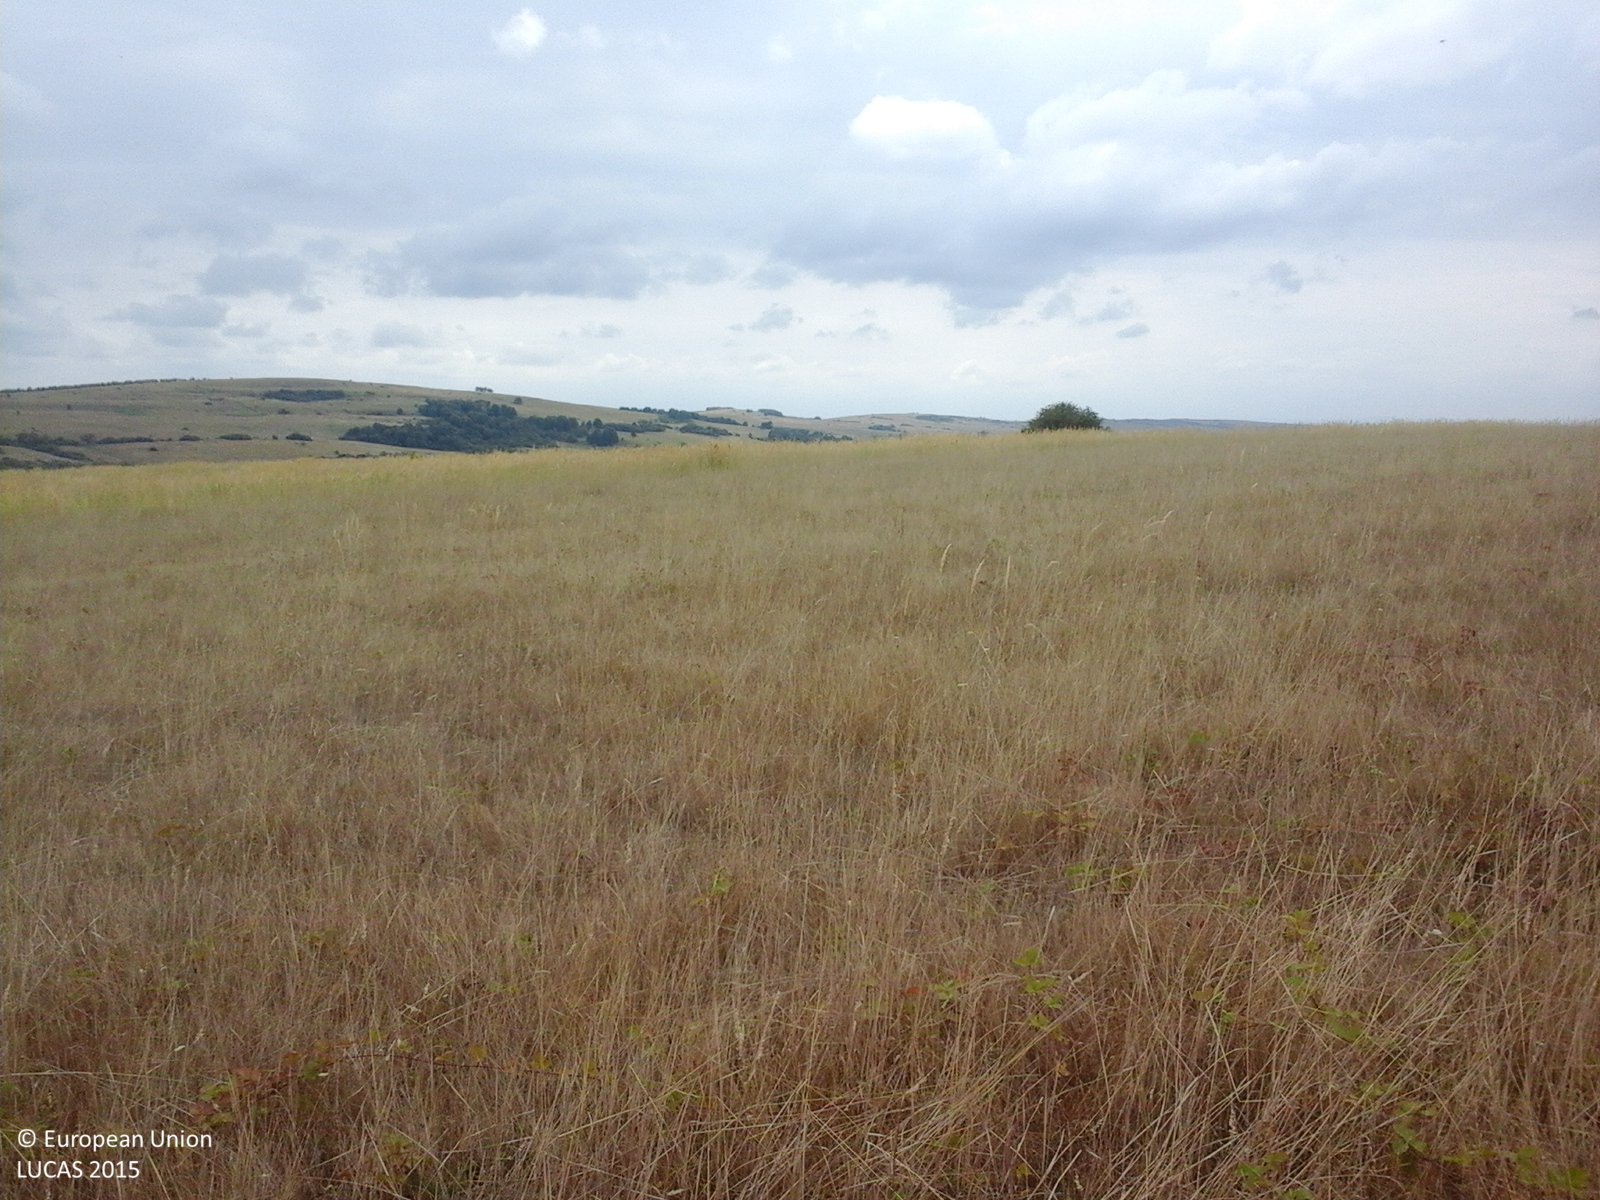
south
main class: Grassland
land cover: Grassland without tree/shrub cover
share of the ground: > 75 %
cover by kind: herbaceous plants 100 %
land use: Agriculture (excluding fallow land and kitchen gardens)
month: August
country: RO
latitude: 45.8922
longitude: 21.8307
